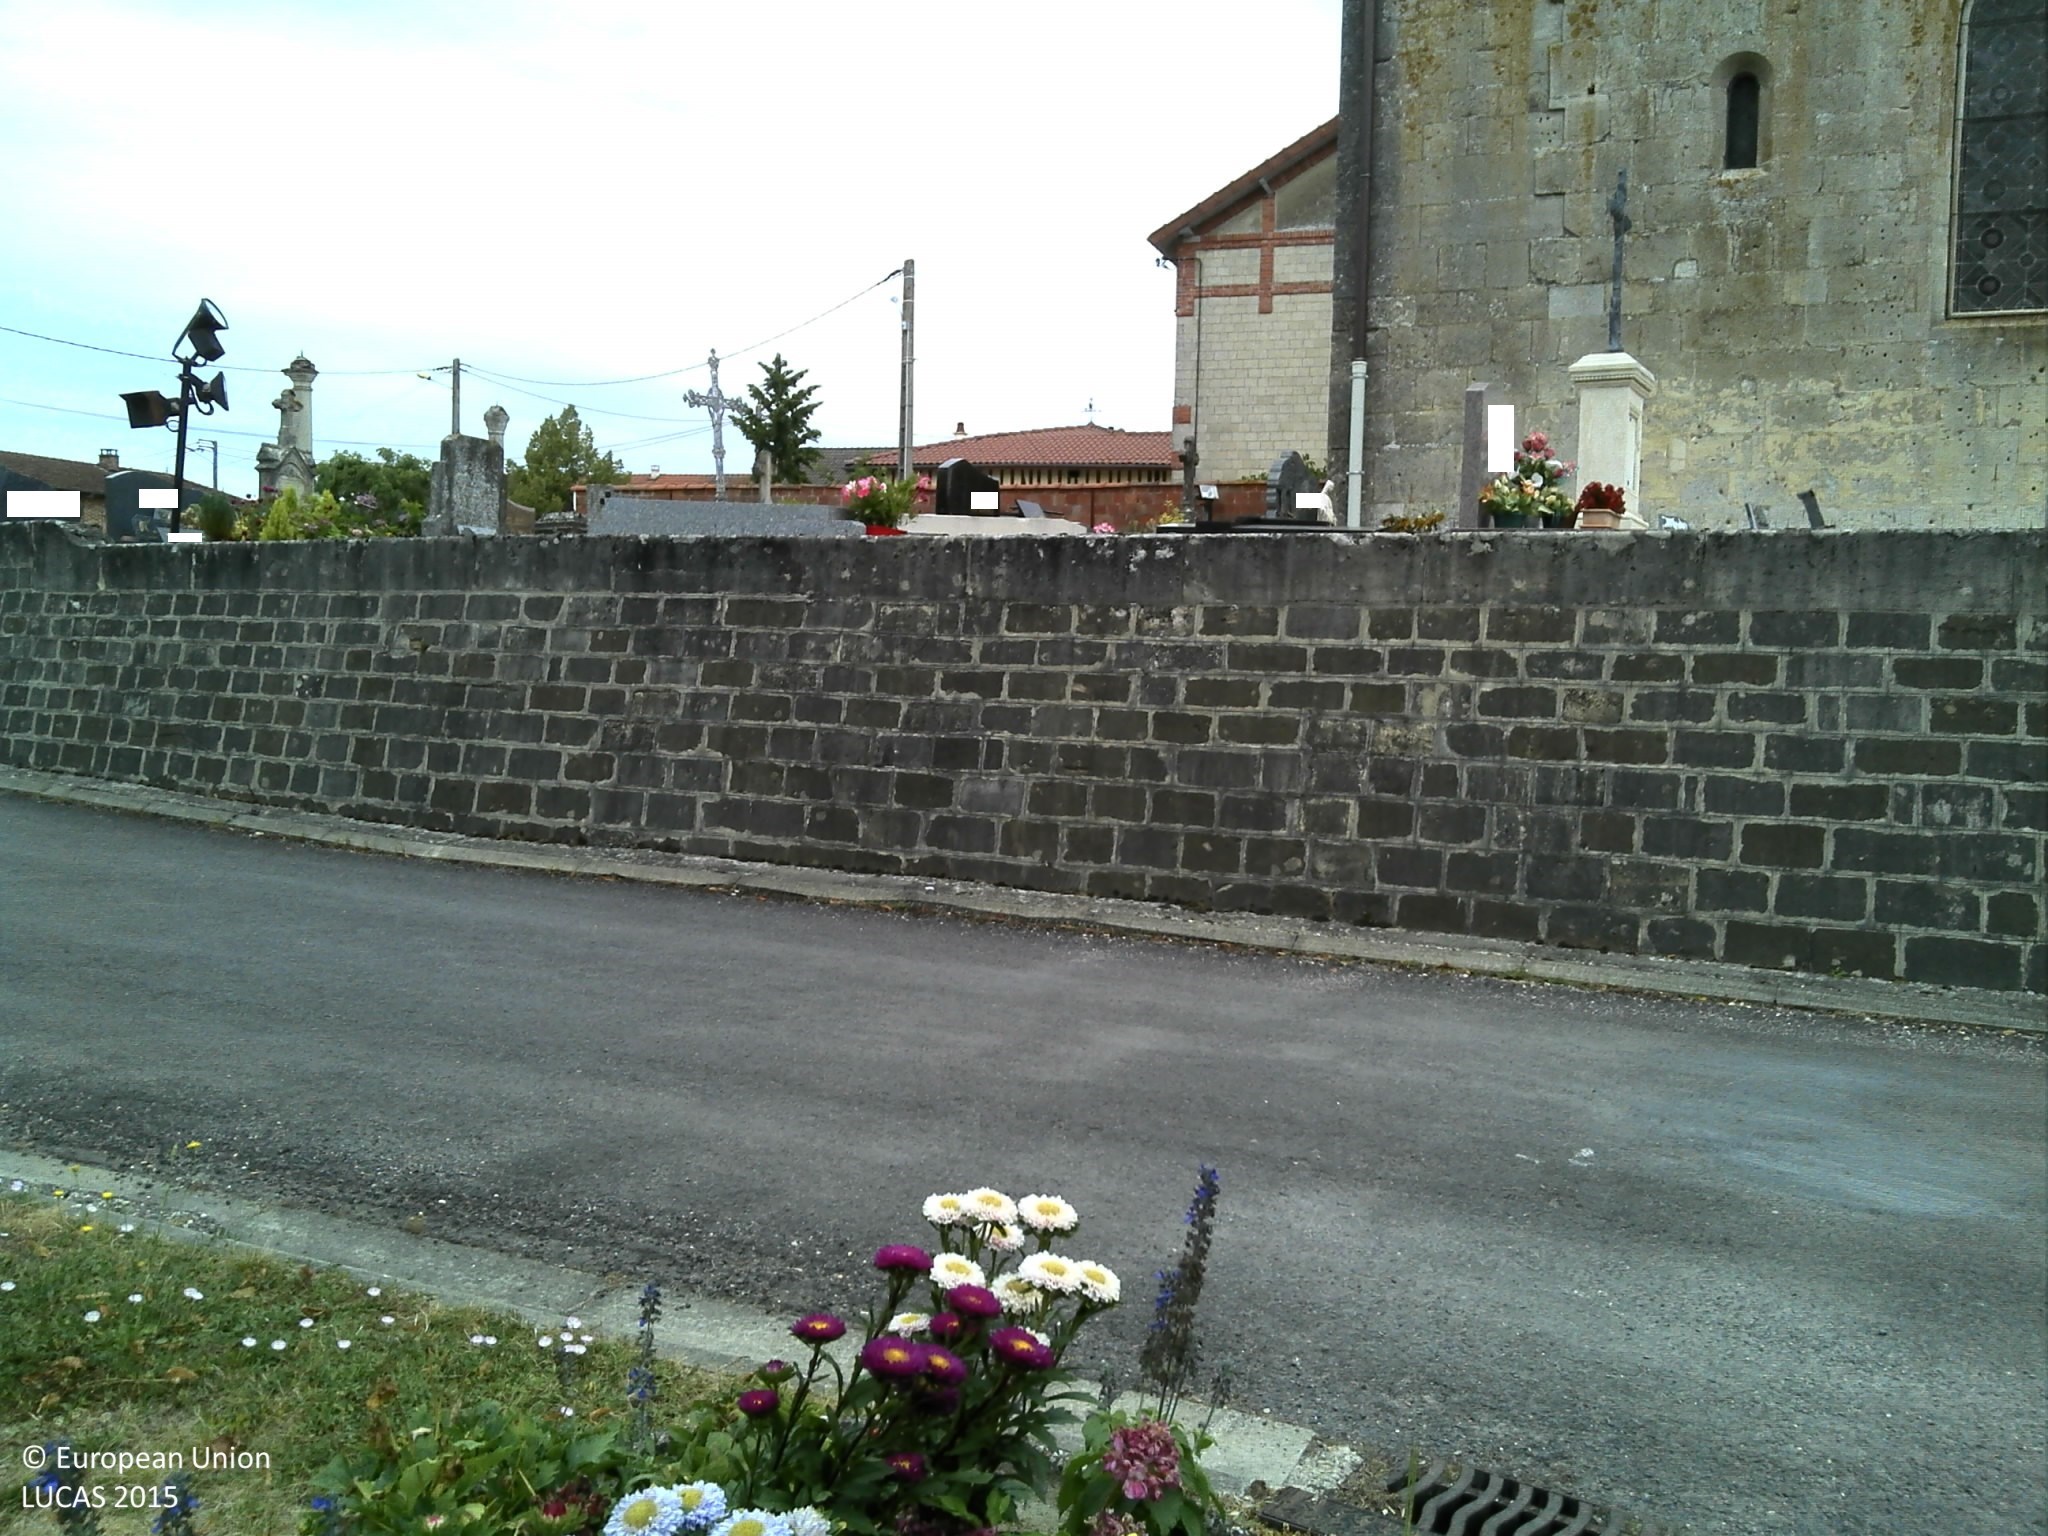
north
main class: Grassland
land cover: Grassland without tree/shrub cover
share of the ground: > 75 %
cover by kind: herbaceous plants 95 %, shrubs 5 %
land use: Residential
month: July
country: FR
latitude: 48.6904
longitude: 4.6858
